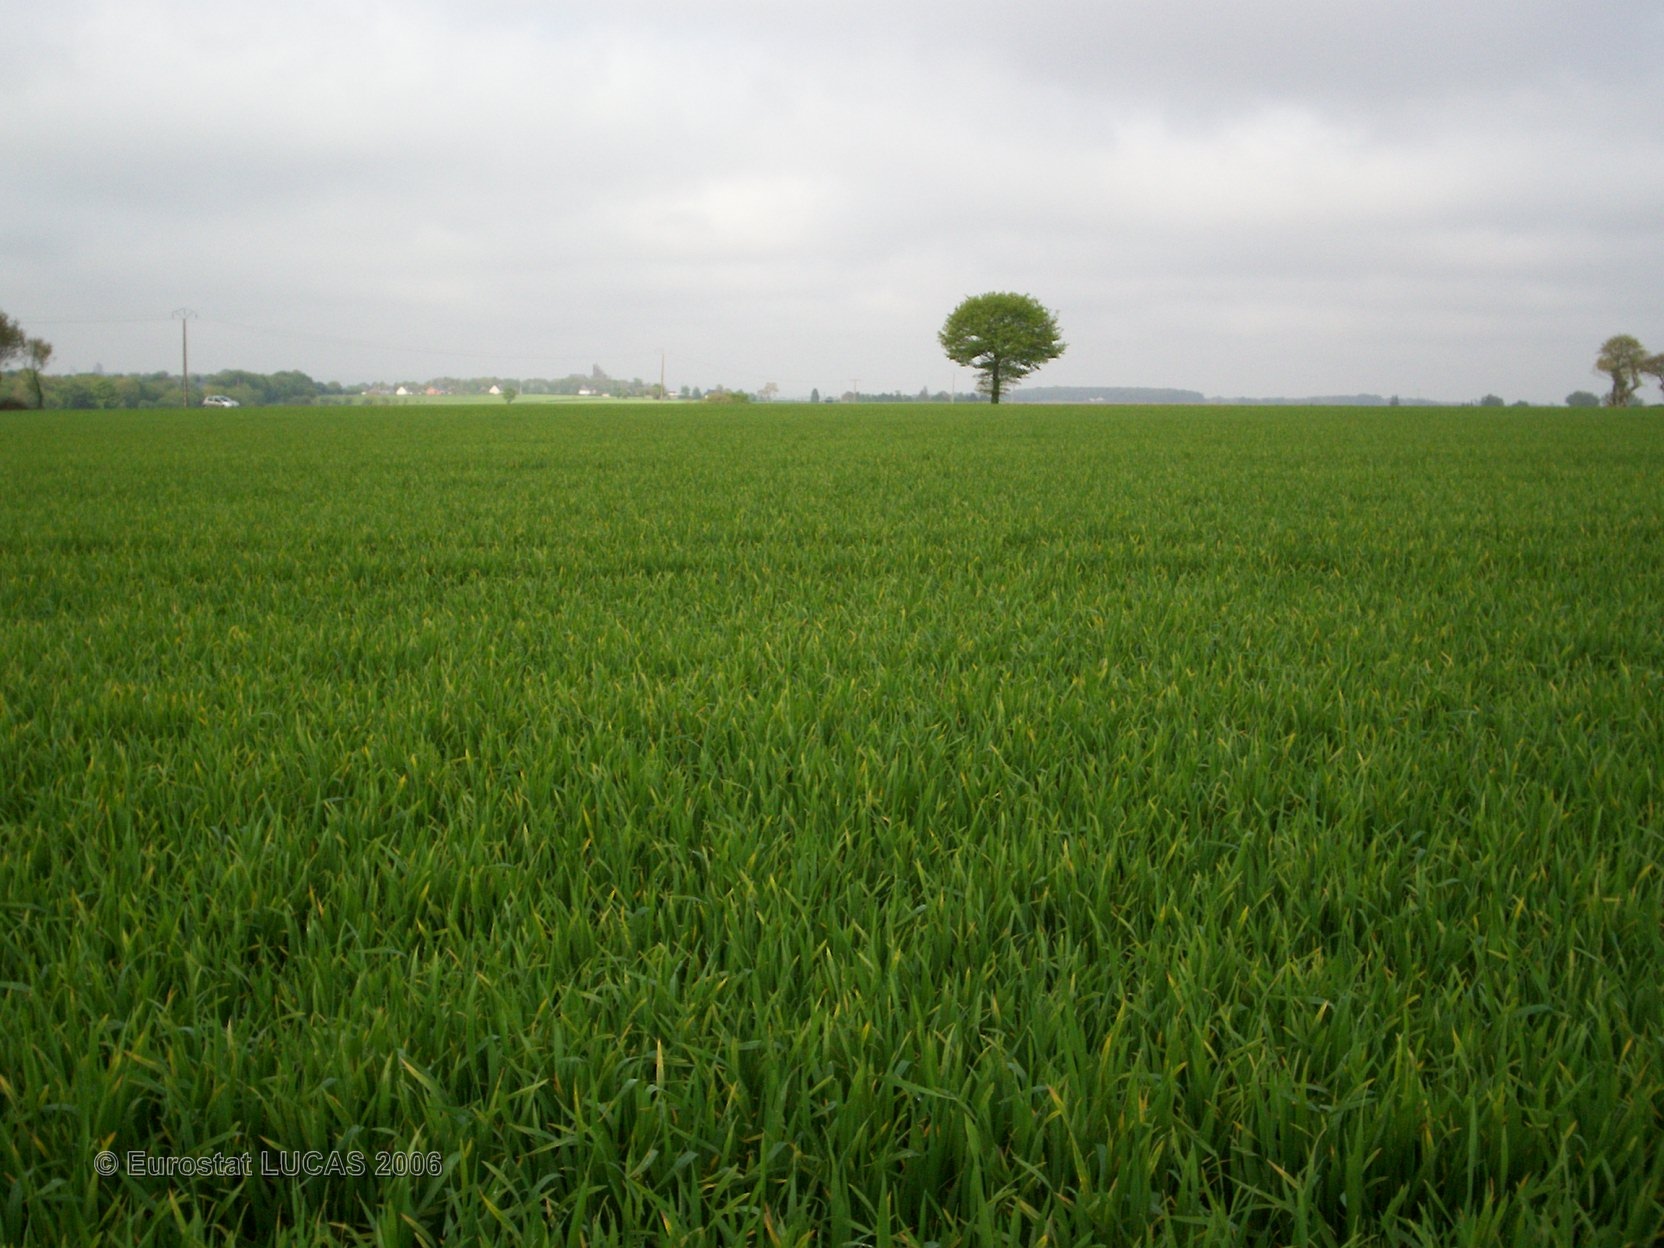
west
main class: Cropland
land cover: Common wheat
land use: Agriculture (excluding fallow land and kitchen gardens)
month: May
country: FR
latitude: 48.1214
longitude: -2.8688
